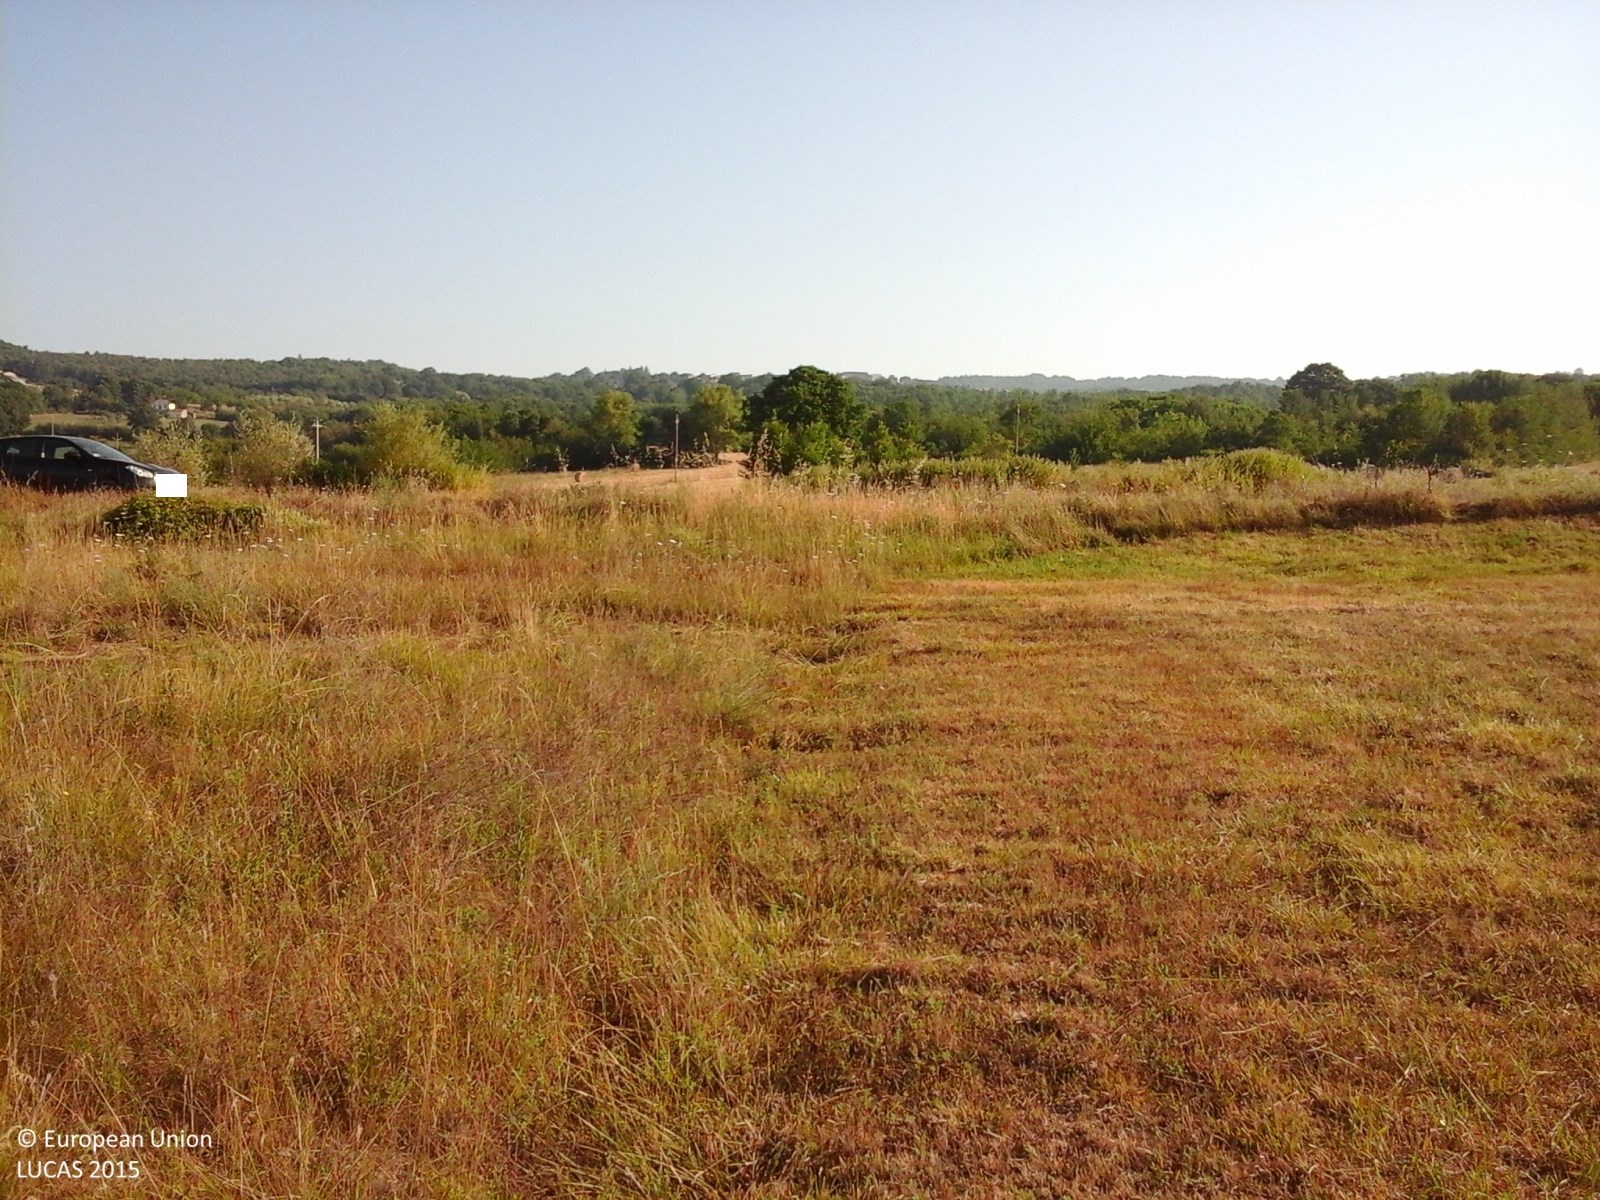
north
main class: Cropland
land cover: Temporary grasslands
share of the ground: > 75 %
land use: Agriculture (excluding fallow land and kitchen gardens)
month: July
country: IT
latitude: 41.4427
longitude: 14.6632
